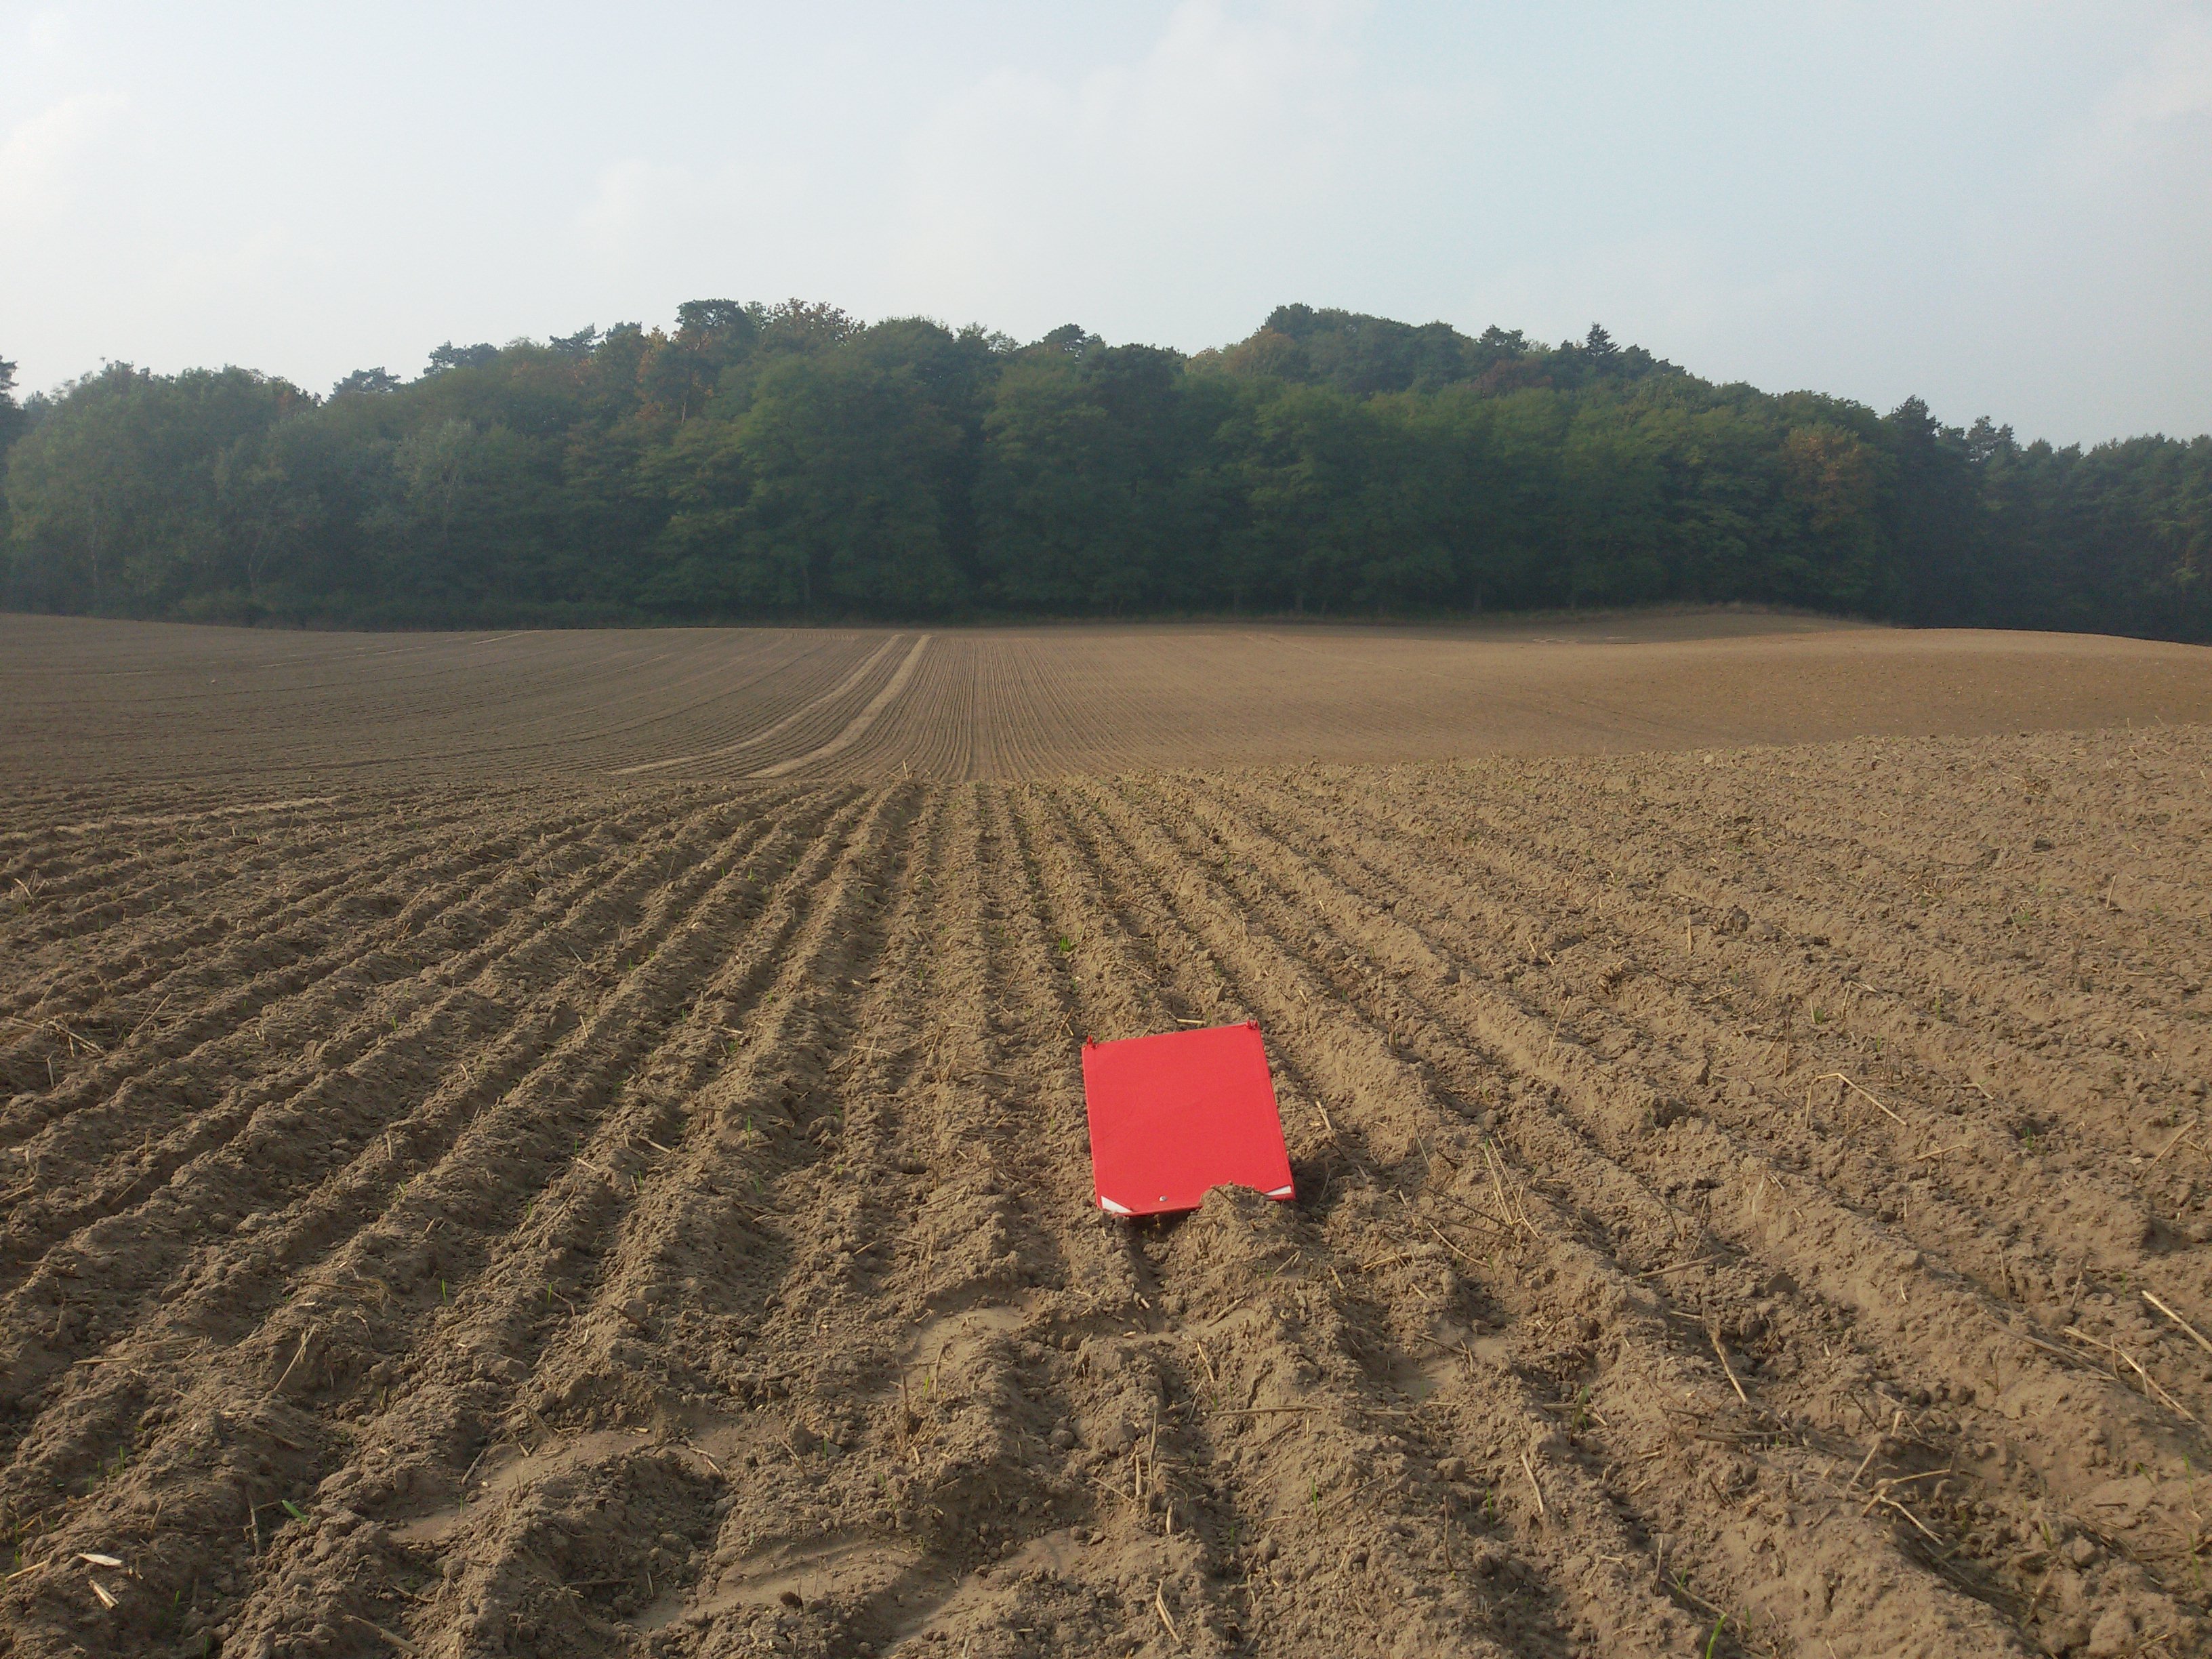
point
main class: Cropland
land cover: Barley
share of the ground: < 10 %
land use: Agriculture (excluding fallow land and kitchen gardens)
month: October
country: PL
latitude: 53.1574
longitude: 14.4728
